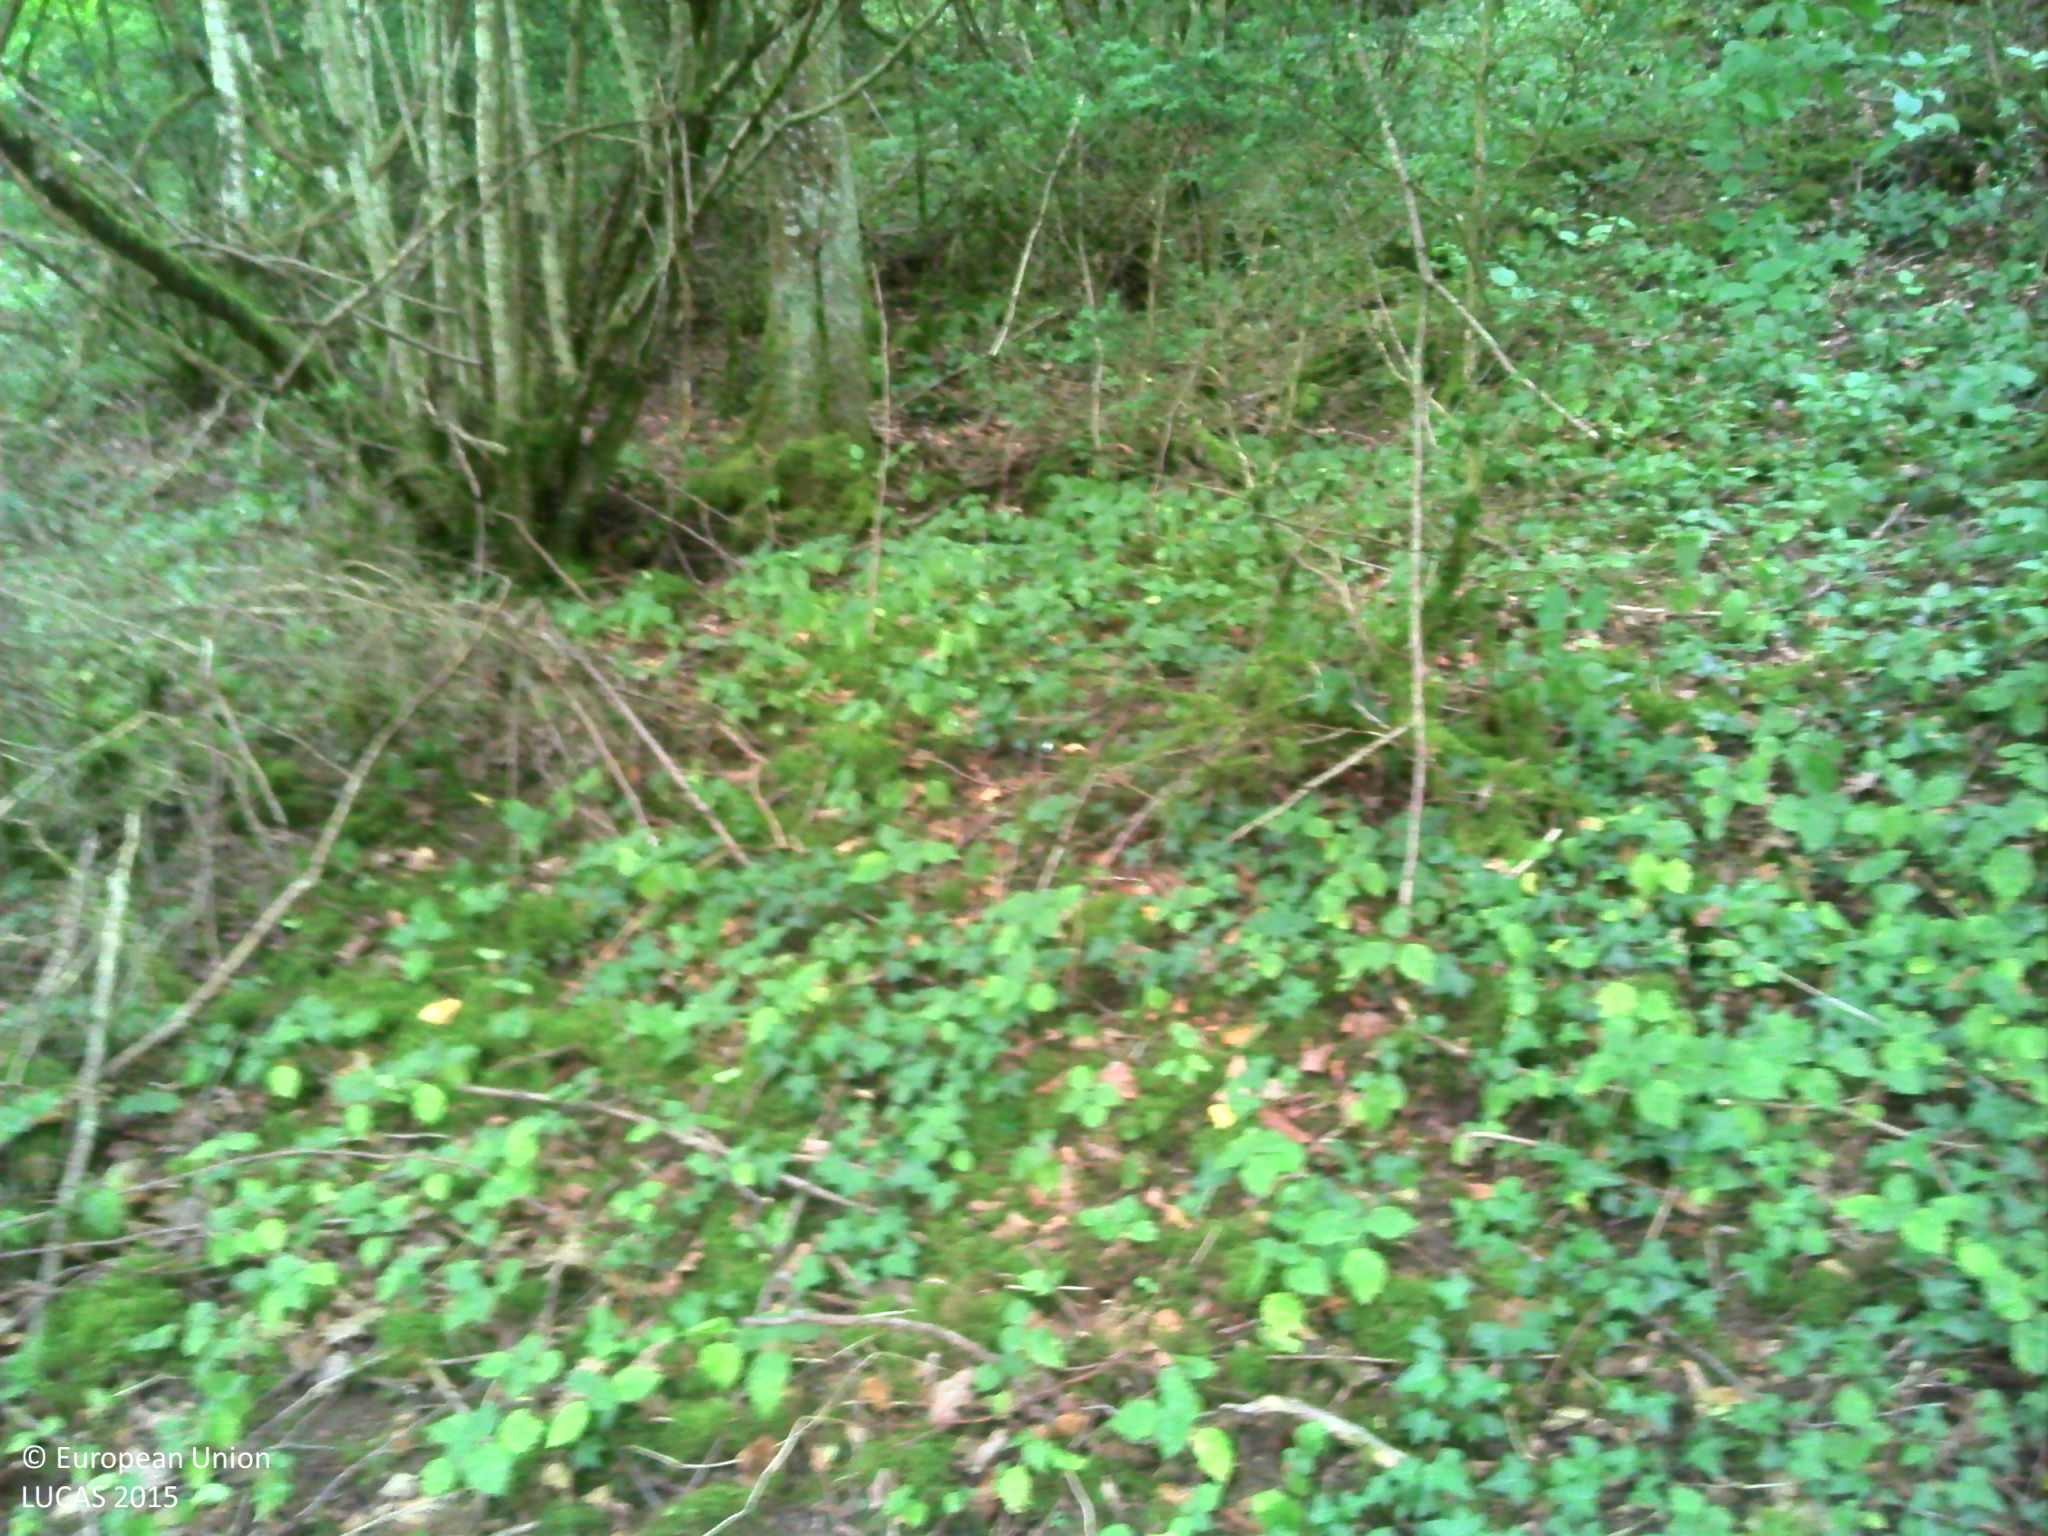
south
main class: Woodland
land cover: Broadleaved woodland
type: mesophytic deciduous forest
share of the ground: > 75 %
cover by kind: broadleaved forest trees 65 %, herbaceous plants 30 %, lichens and mosses 5 %
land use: Forestry
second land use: Amenities, museums, leisure
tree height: > 5 m
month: June
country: FR
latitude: 46.5495
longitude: 4.7979
